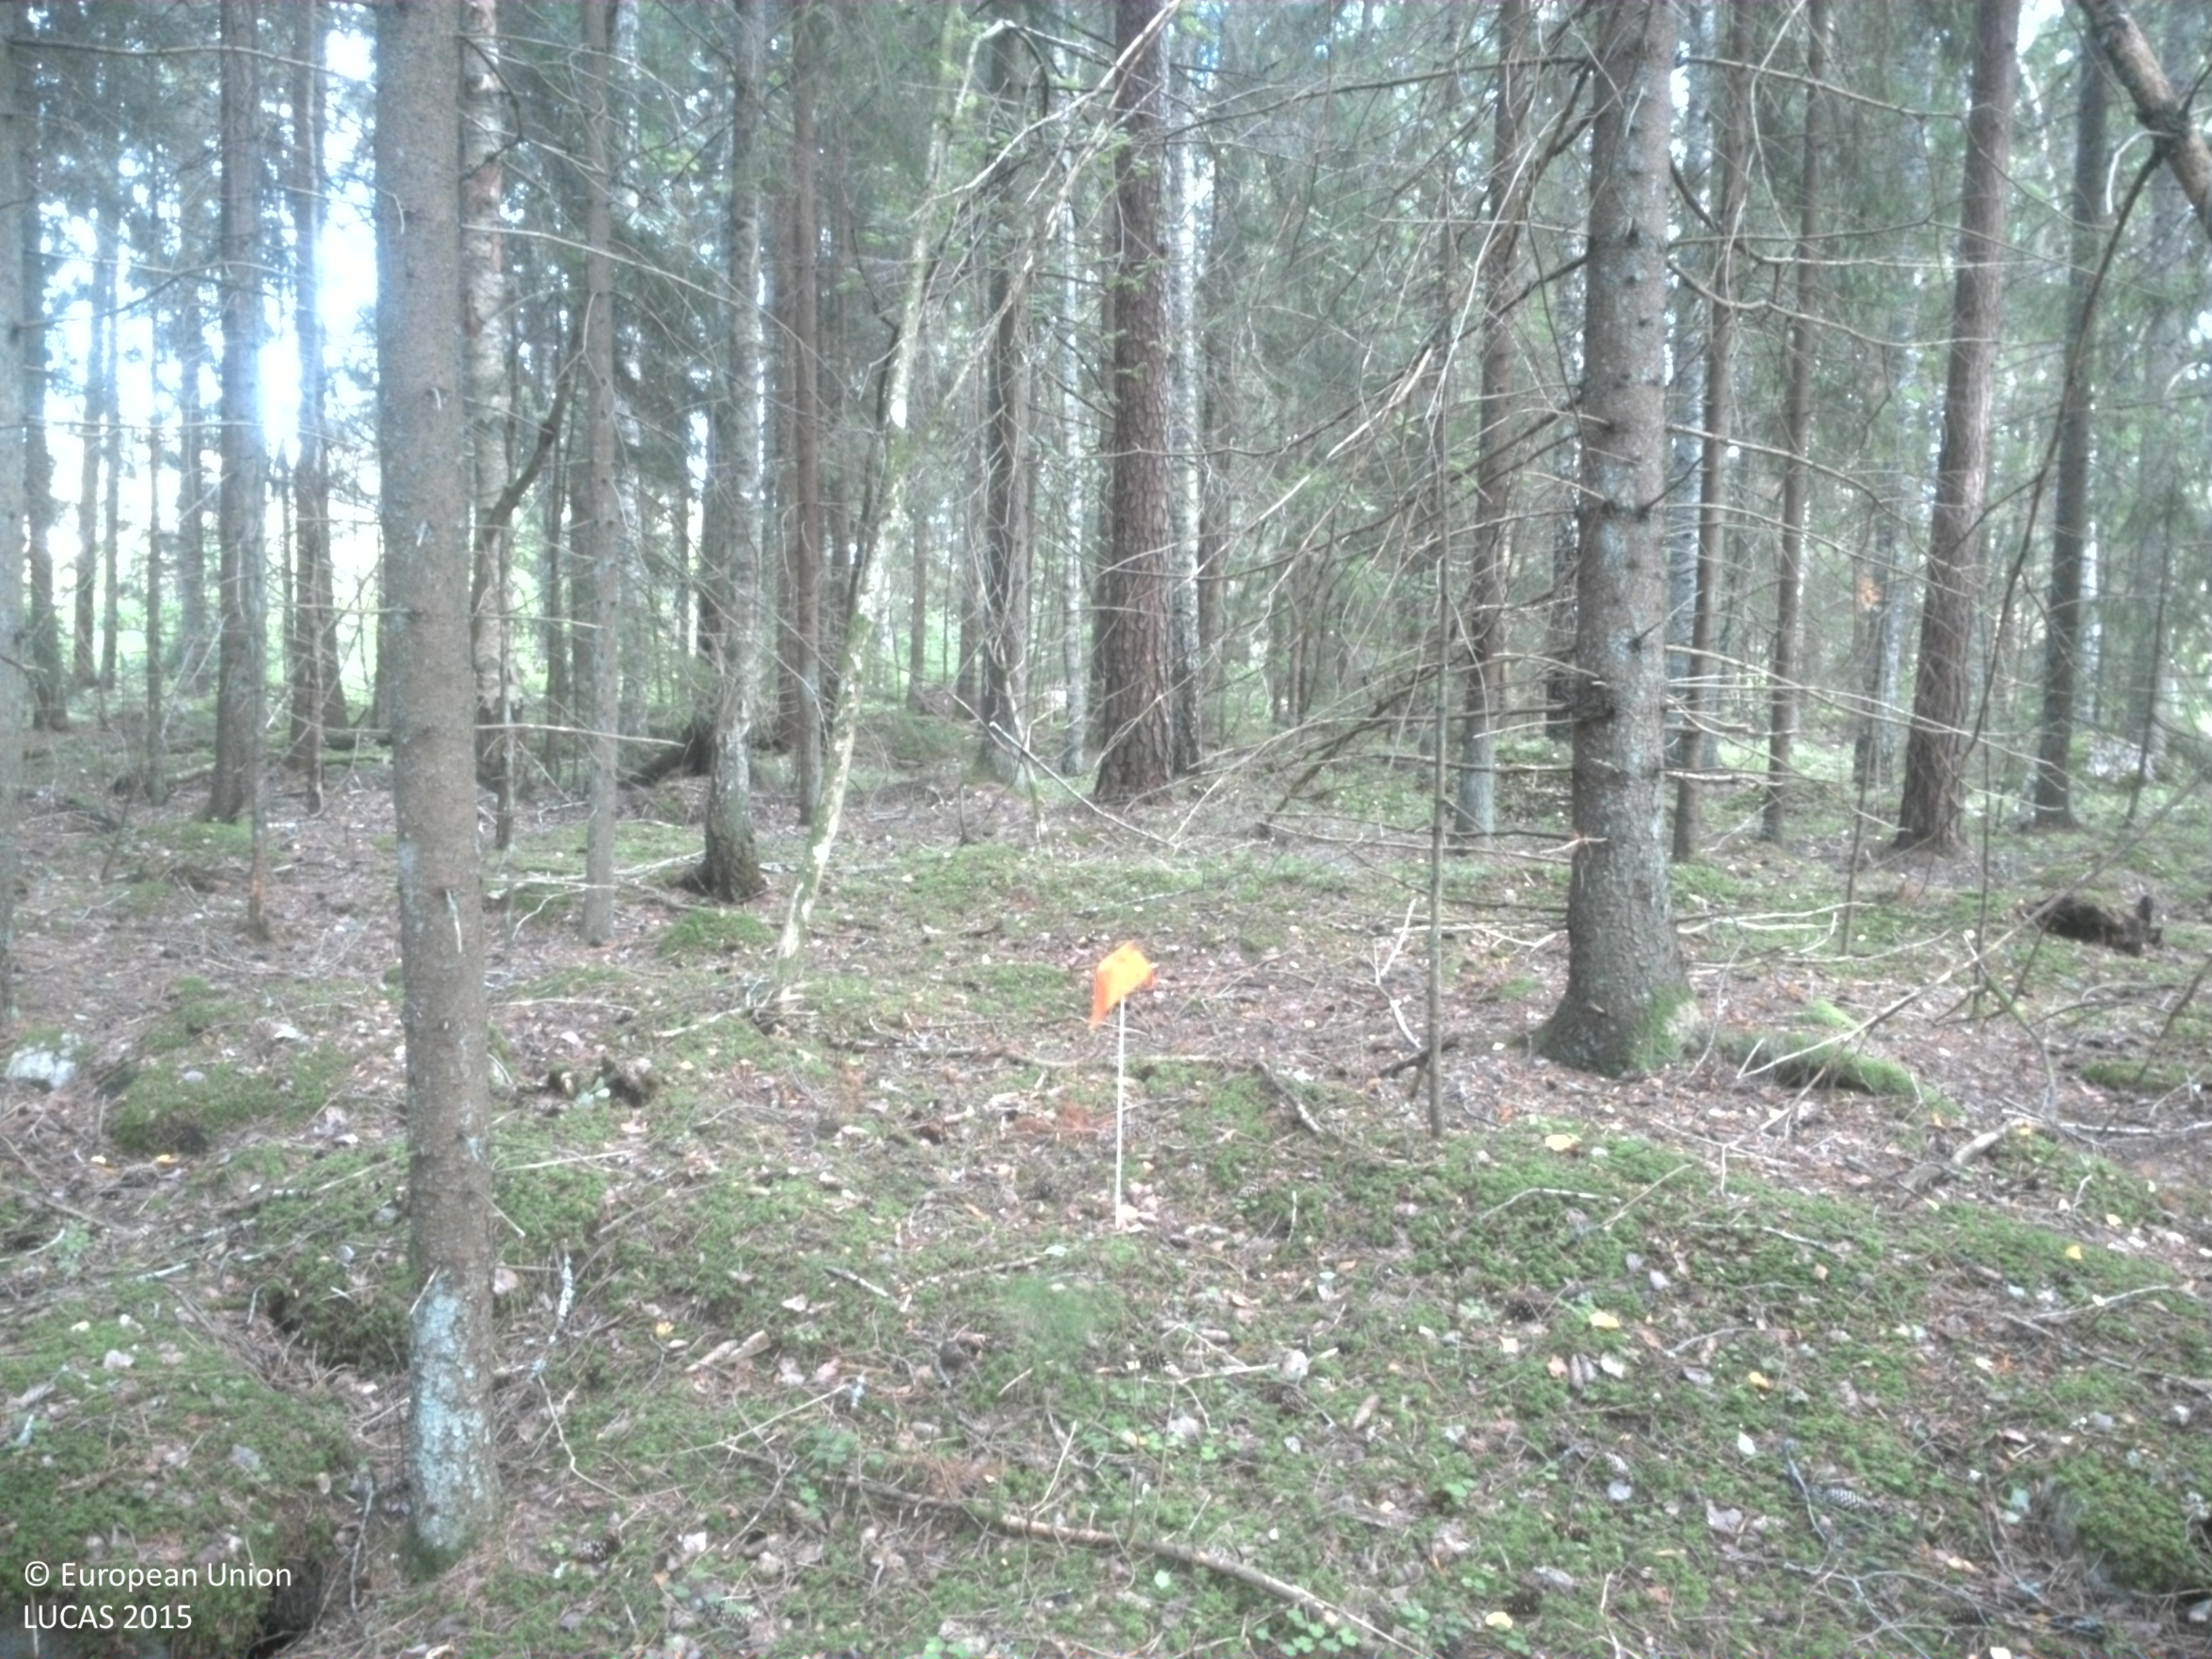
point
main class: Woodland
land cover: Spruce dominated coniferous woodland
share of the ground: > 75 %
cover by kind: coniferous forest trees 70 %, lichens and mosses 15 %, broadleaved forest trees 10 %, shrubs 5 %
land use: Forestry
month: September
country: SE
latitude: 59.4910
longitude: 15.6246
